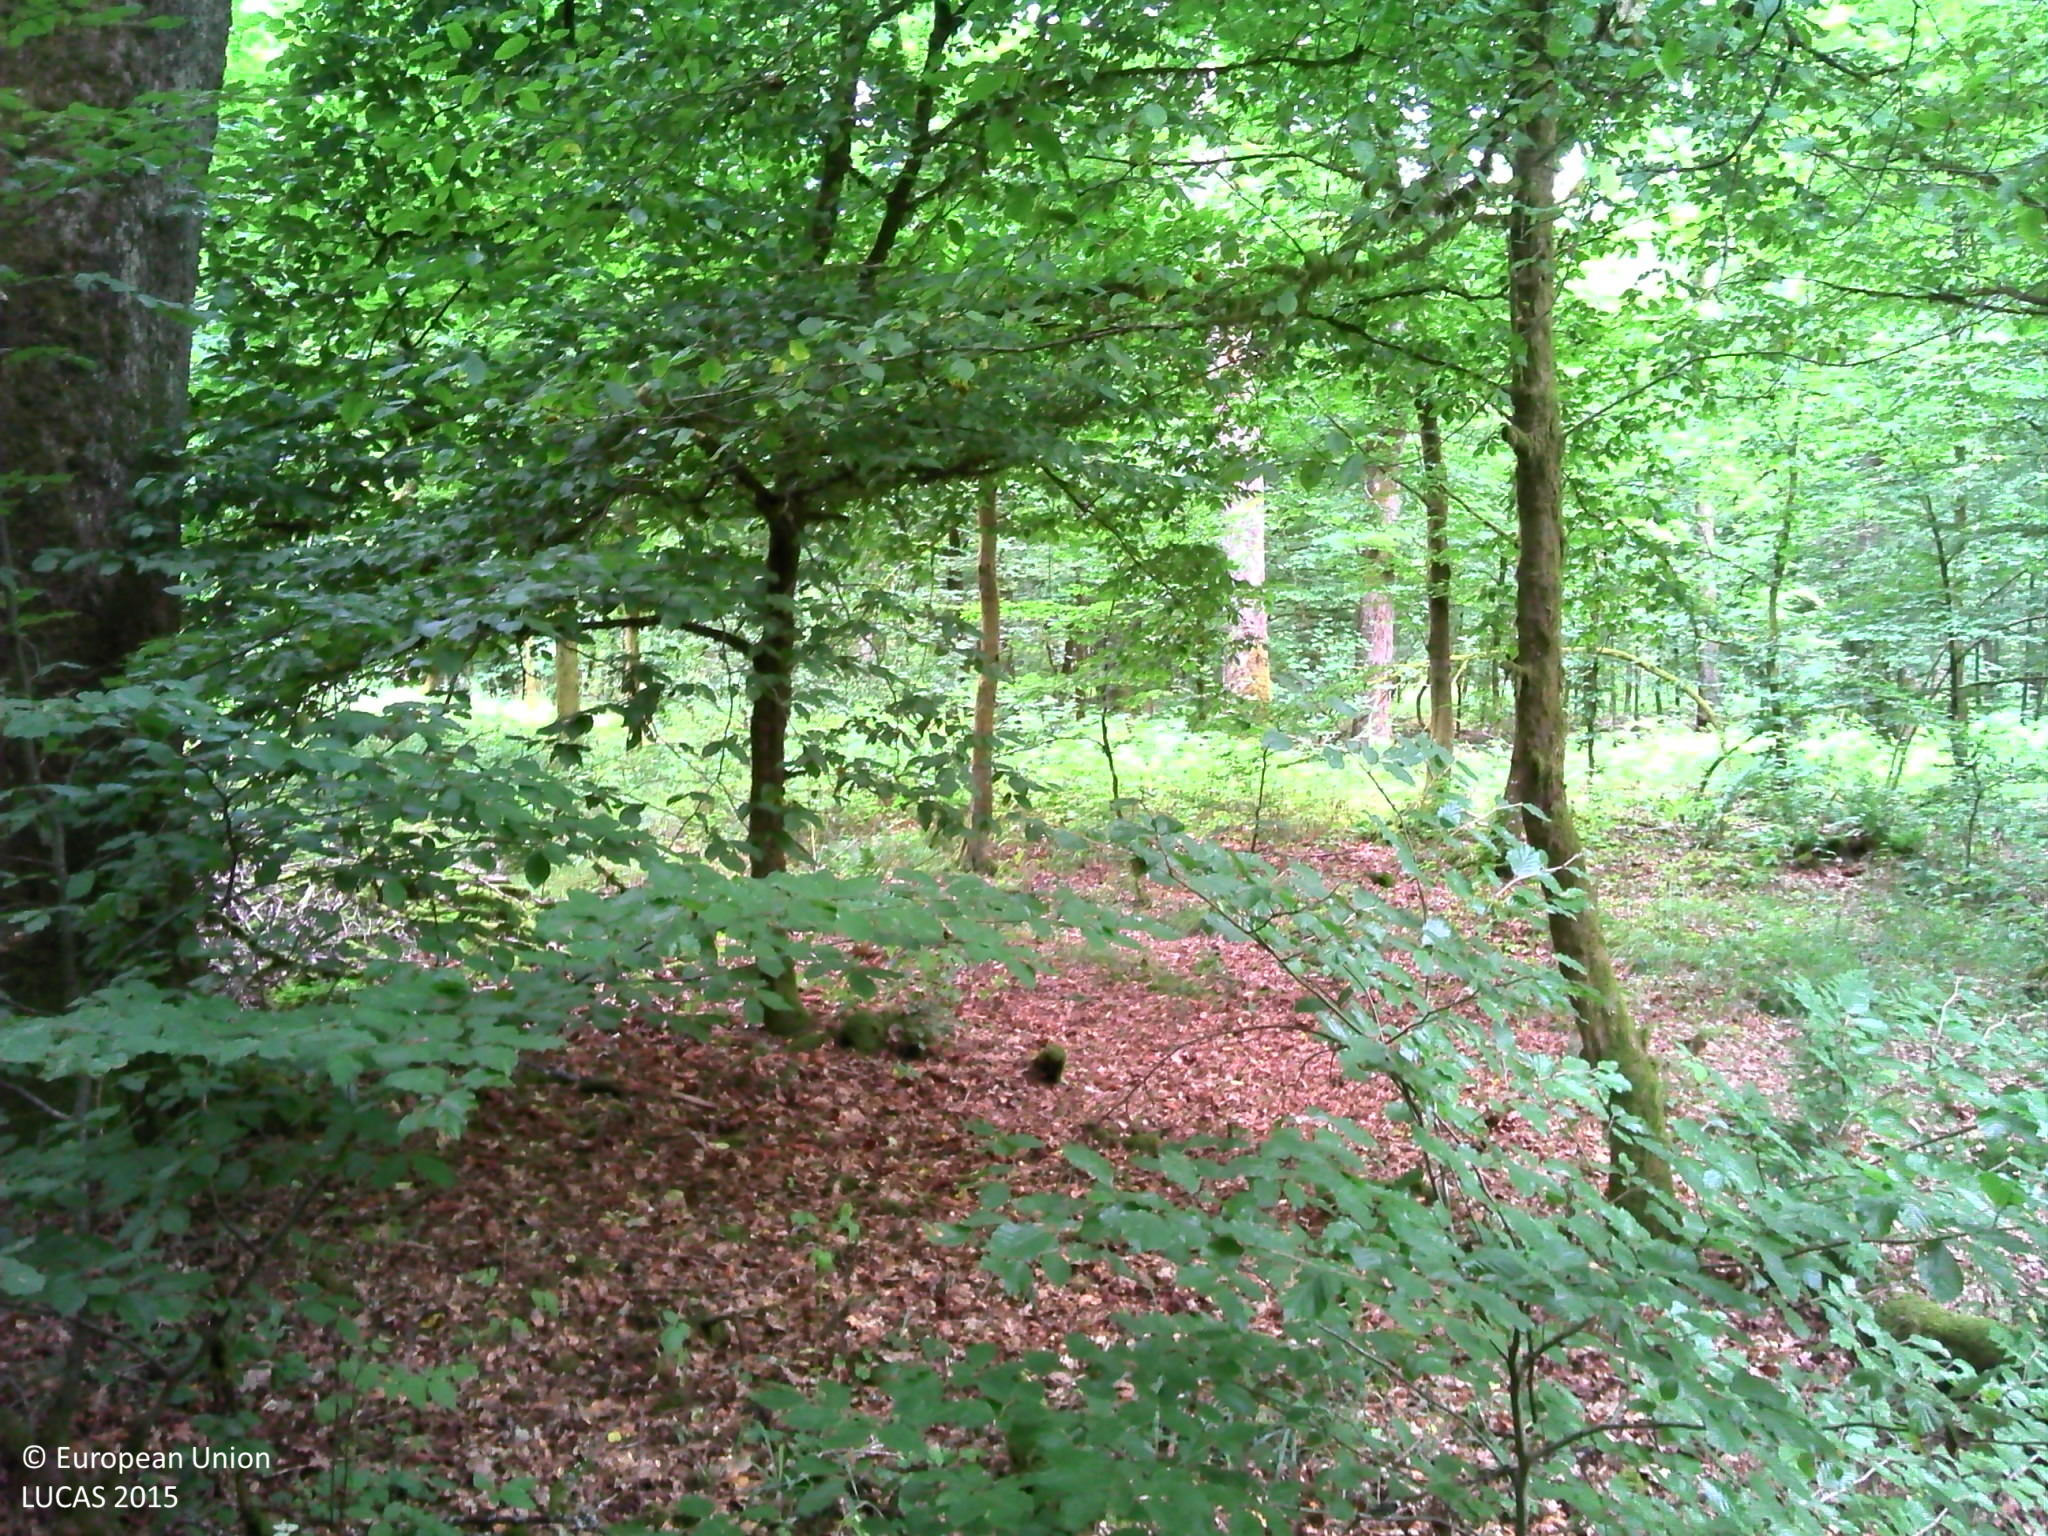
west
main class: Woodland
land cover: Broadleaved woodland
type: acidophilous oak and oak-birch forest
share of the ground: > 75 %
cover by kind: broadleaved forest trees 80 %, shrubs 10 %, herbaceous plants 10 %
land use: Forestry
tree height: > 5 m
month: July
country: BE
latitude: 49.6505
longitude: 5.6357
